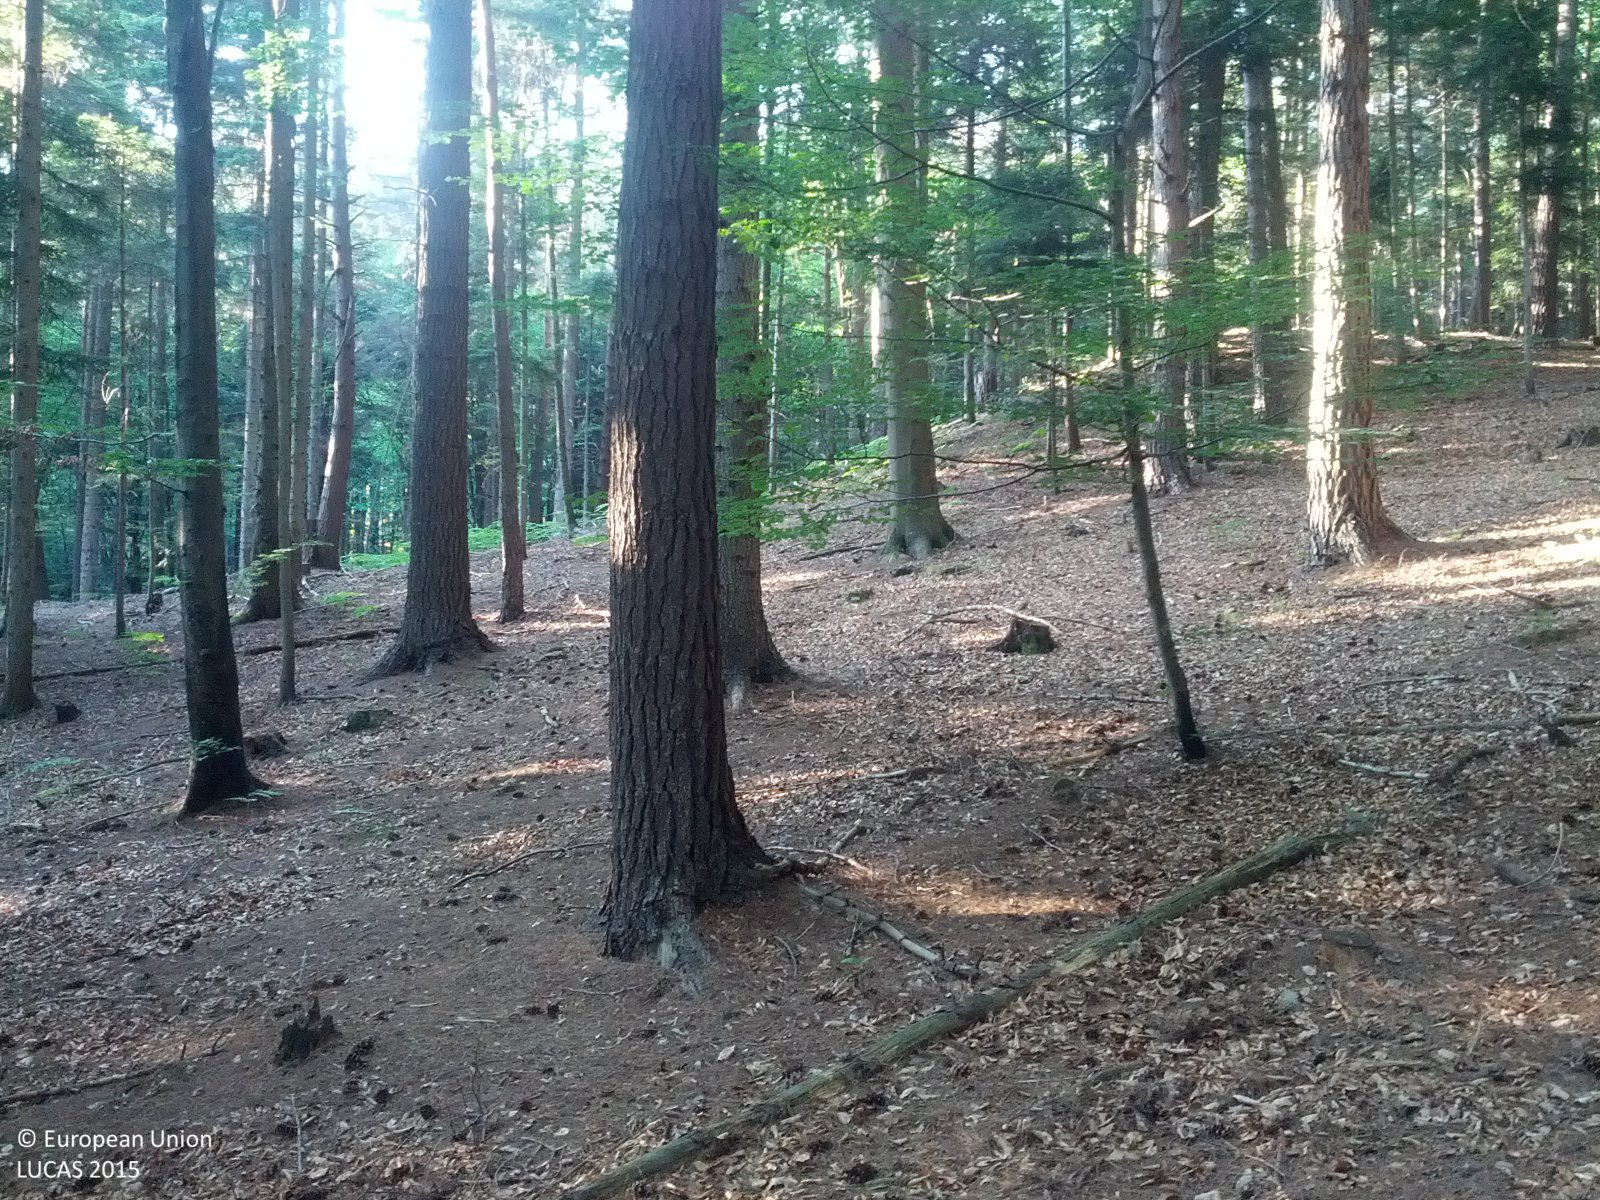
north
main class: Woodland
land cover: Pine dominated mixed woodland
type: hemiboreal forest and nemoral coniferous forest and mixed broadleaved-coniferous forest
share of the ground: > 75 %
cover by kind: broadleaved forest trees 50 %, coniferous forest trees 40 %, herbaceous plants 5 %, lichens and mosses 5 %
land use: Forestry
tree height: > 5 m
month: June
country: AT
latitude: 48.1841
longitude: 16.0431
